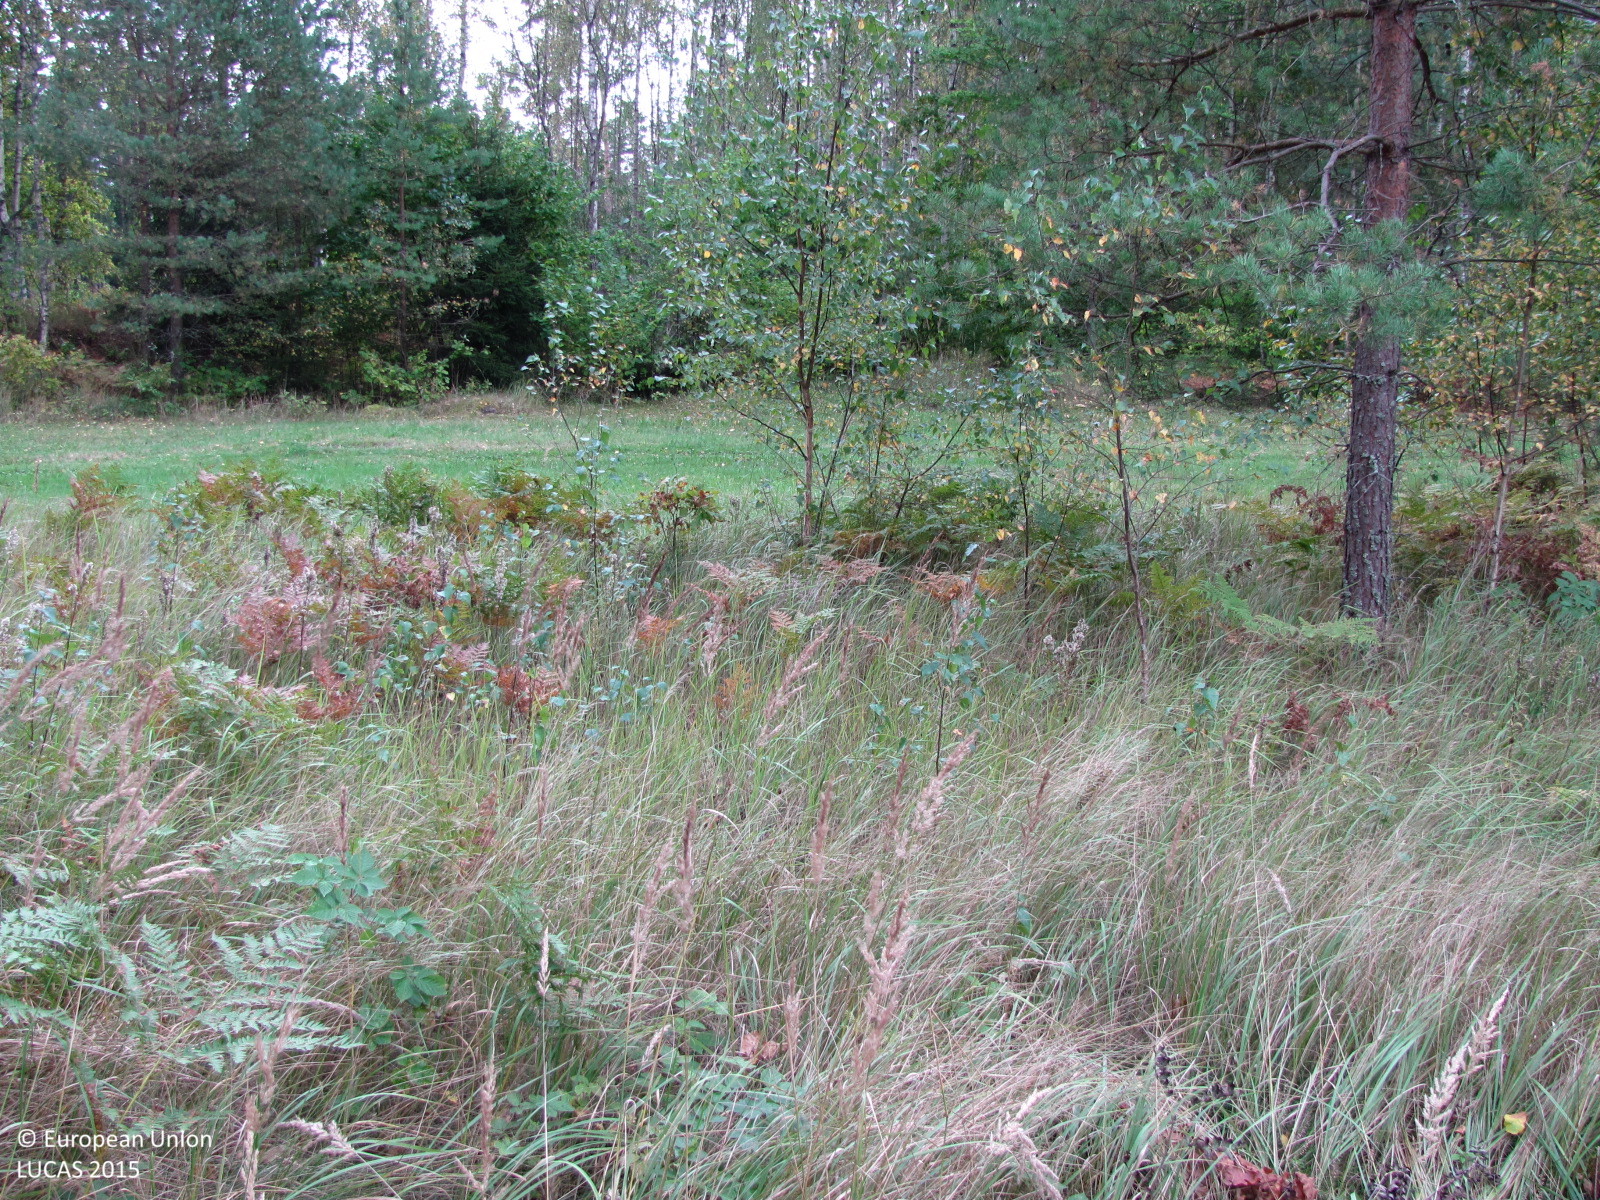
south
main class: Grassland
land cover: Grassland with sparse tree/shrub cover
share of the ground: > 75 %
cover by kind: herbaceous plants 95 %, broadleaved forest trees 5 %
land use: Semi-natural and natural areas not in use
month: September
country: LV
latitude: 57.1351
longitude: 24.6529
